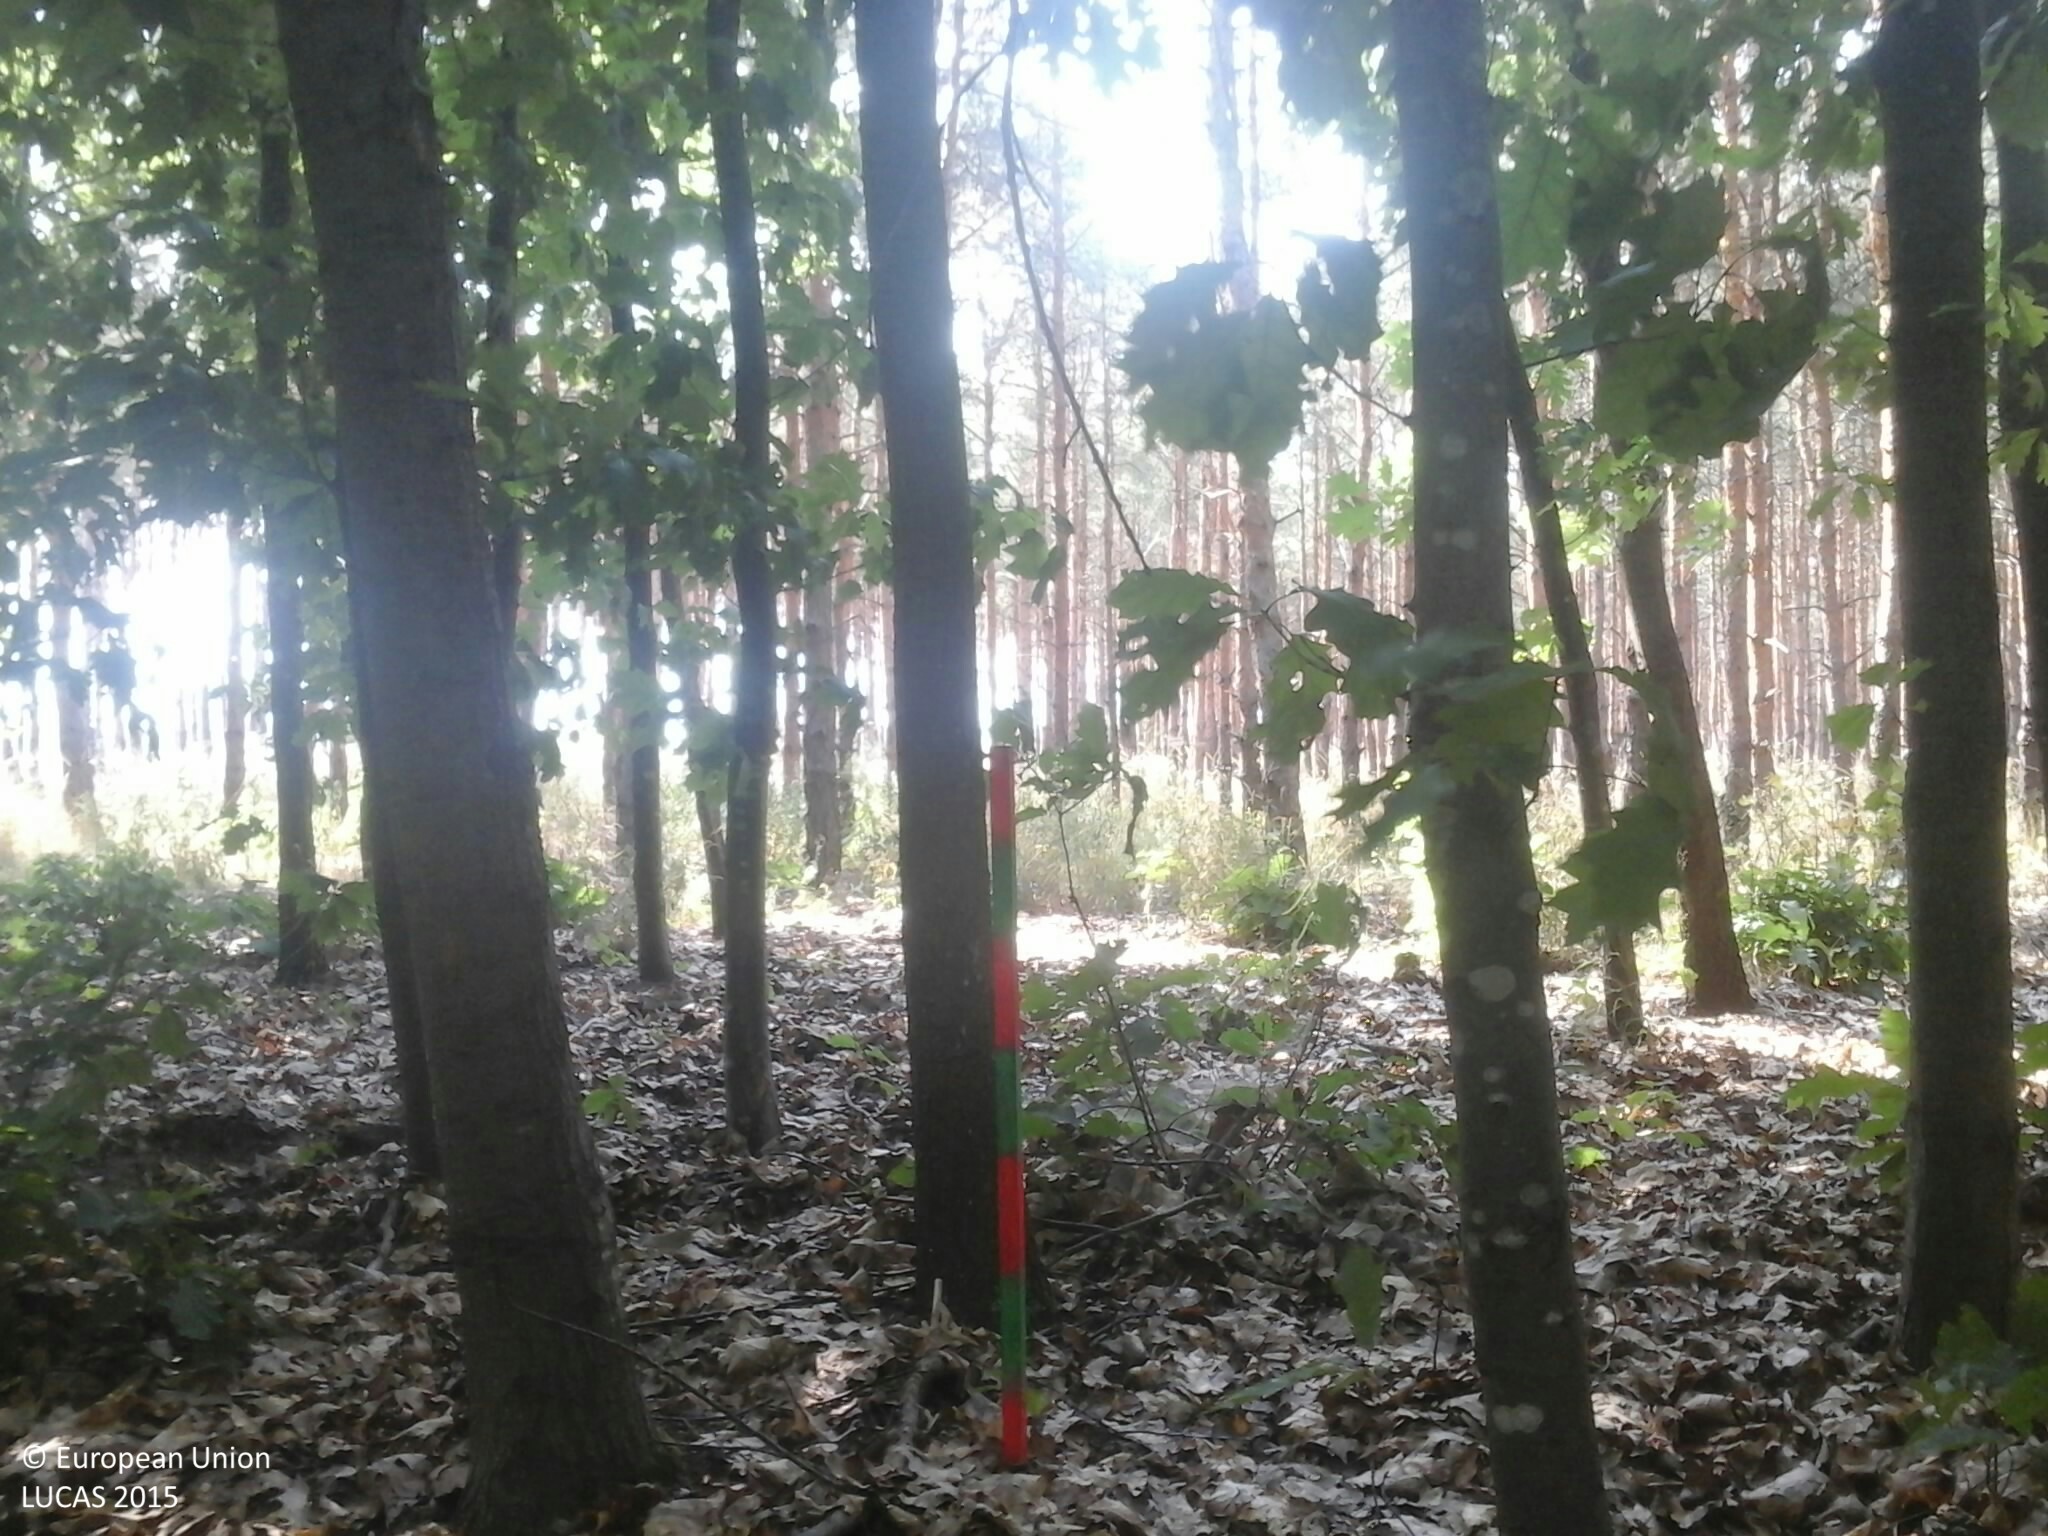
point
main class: Woodland
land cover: Broadleaved woodland
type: acidophilous oak and oak-birch forest
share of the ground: > 75 %
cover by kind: broadleaved forest trees 95 %, unconsolidated bare surface 5 %
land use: Forestry
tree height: > 5 m
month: June
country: HU
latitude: 46.8672
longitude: 17.2070
